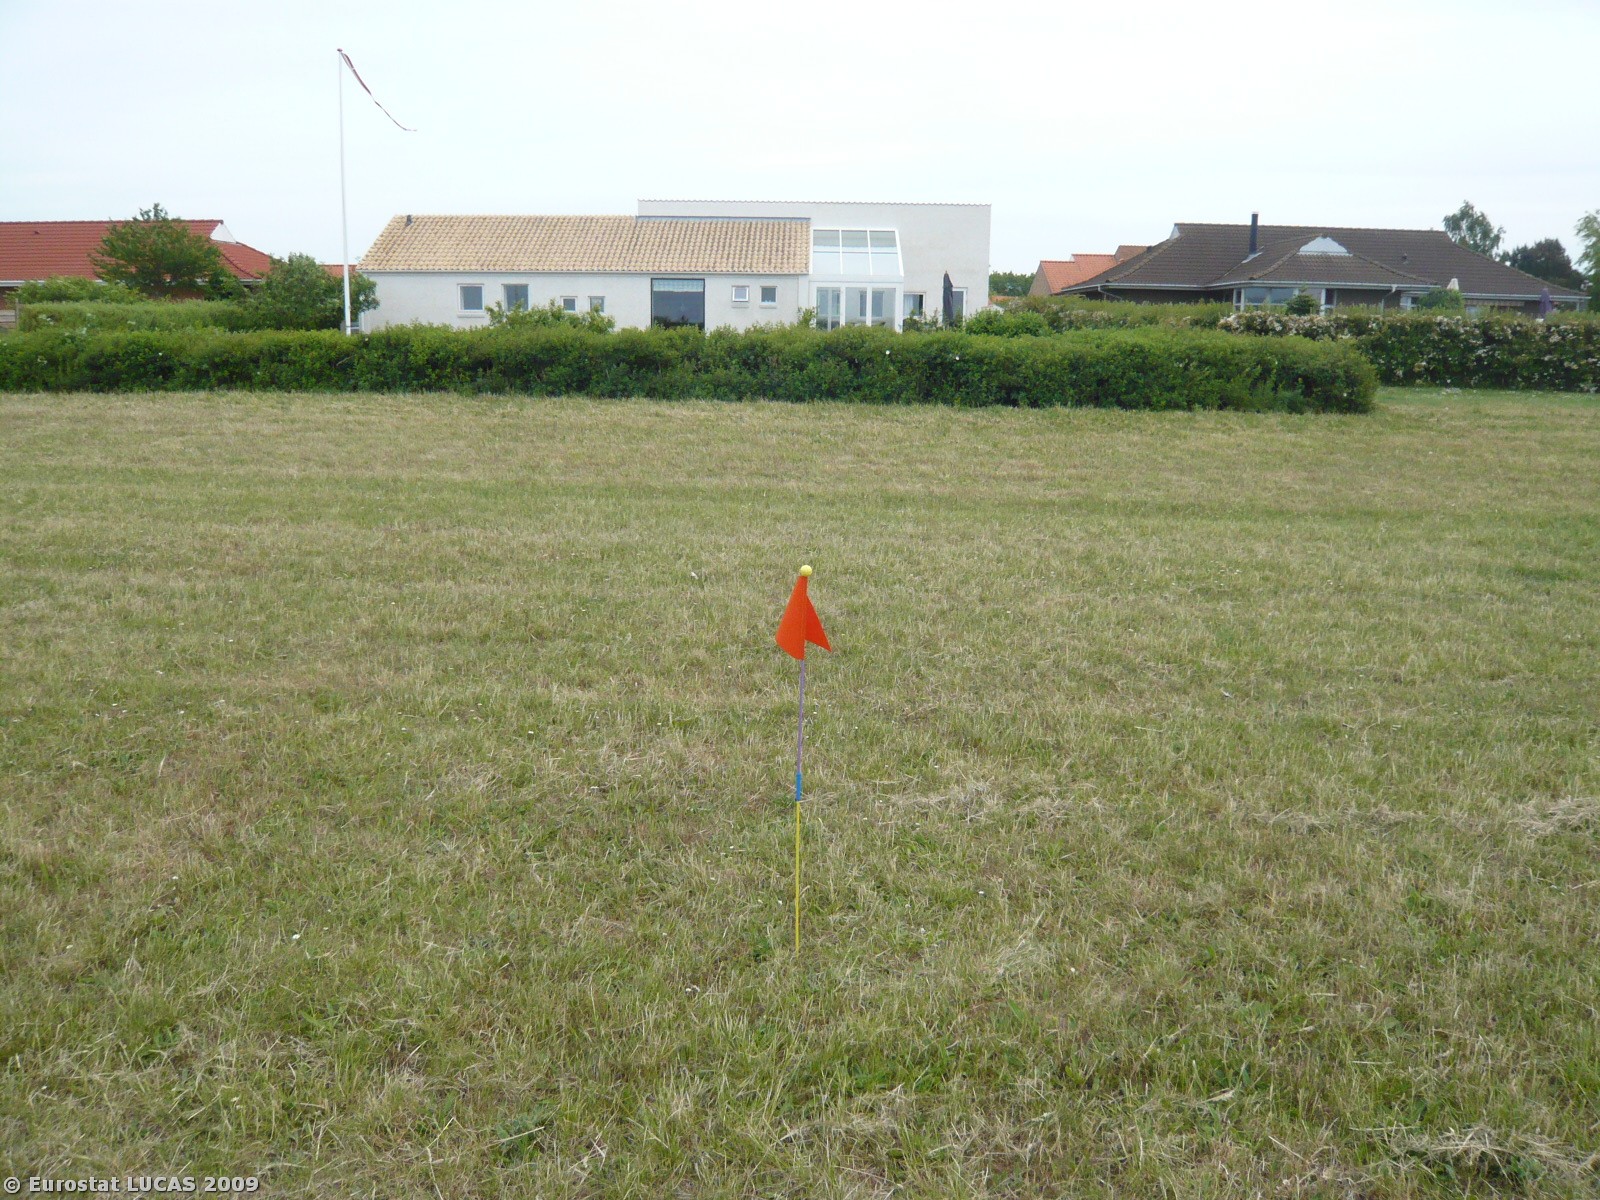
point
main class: Grassland
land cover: Grassland without tree/shrub cover
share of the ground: > 75 %
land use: Amenities, museums, leisure
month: June
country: DK
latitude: 55.2643
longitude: 11.3051
